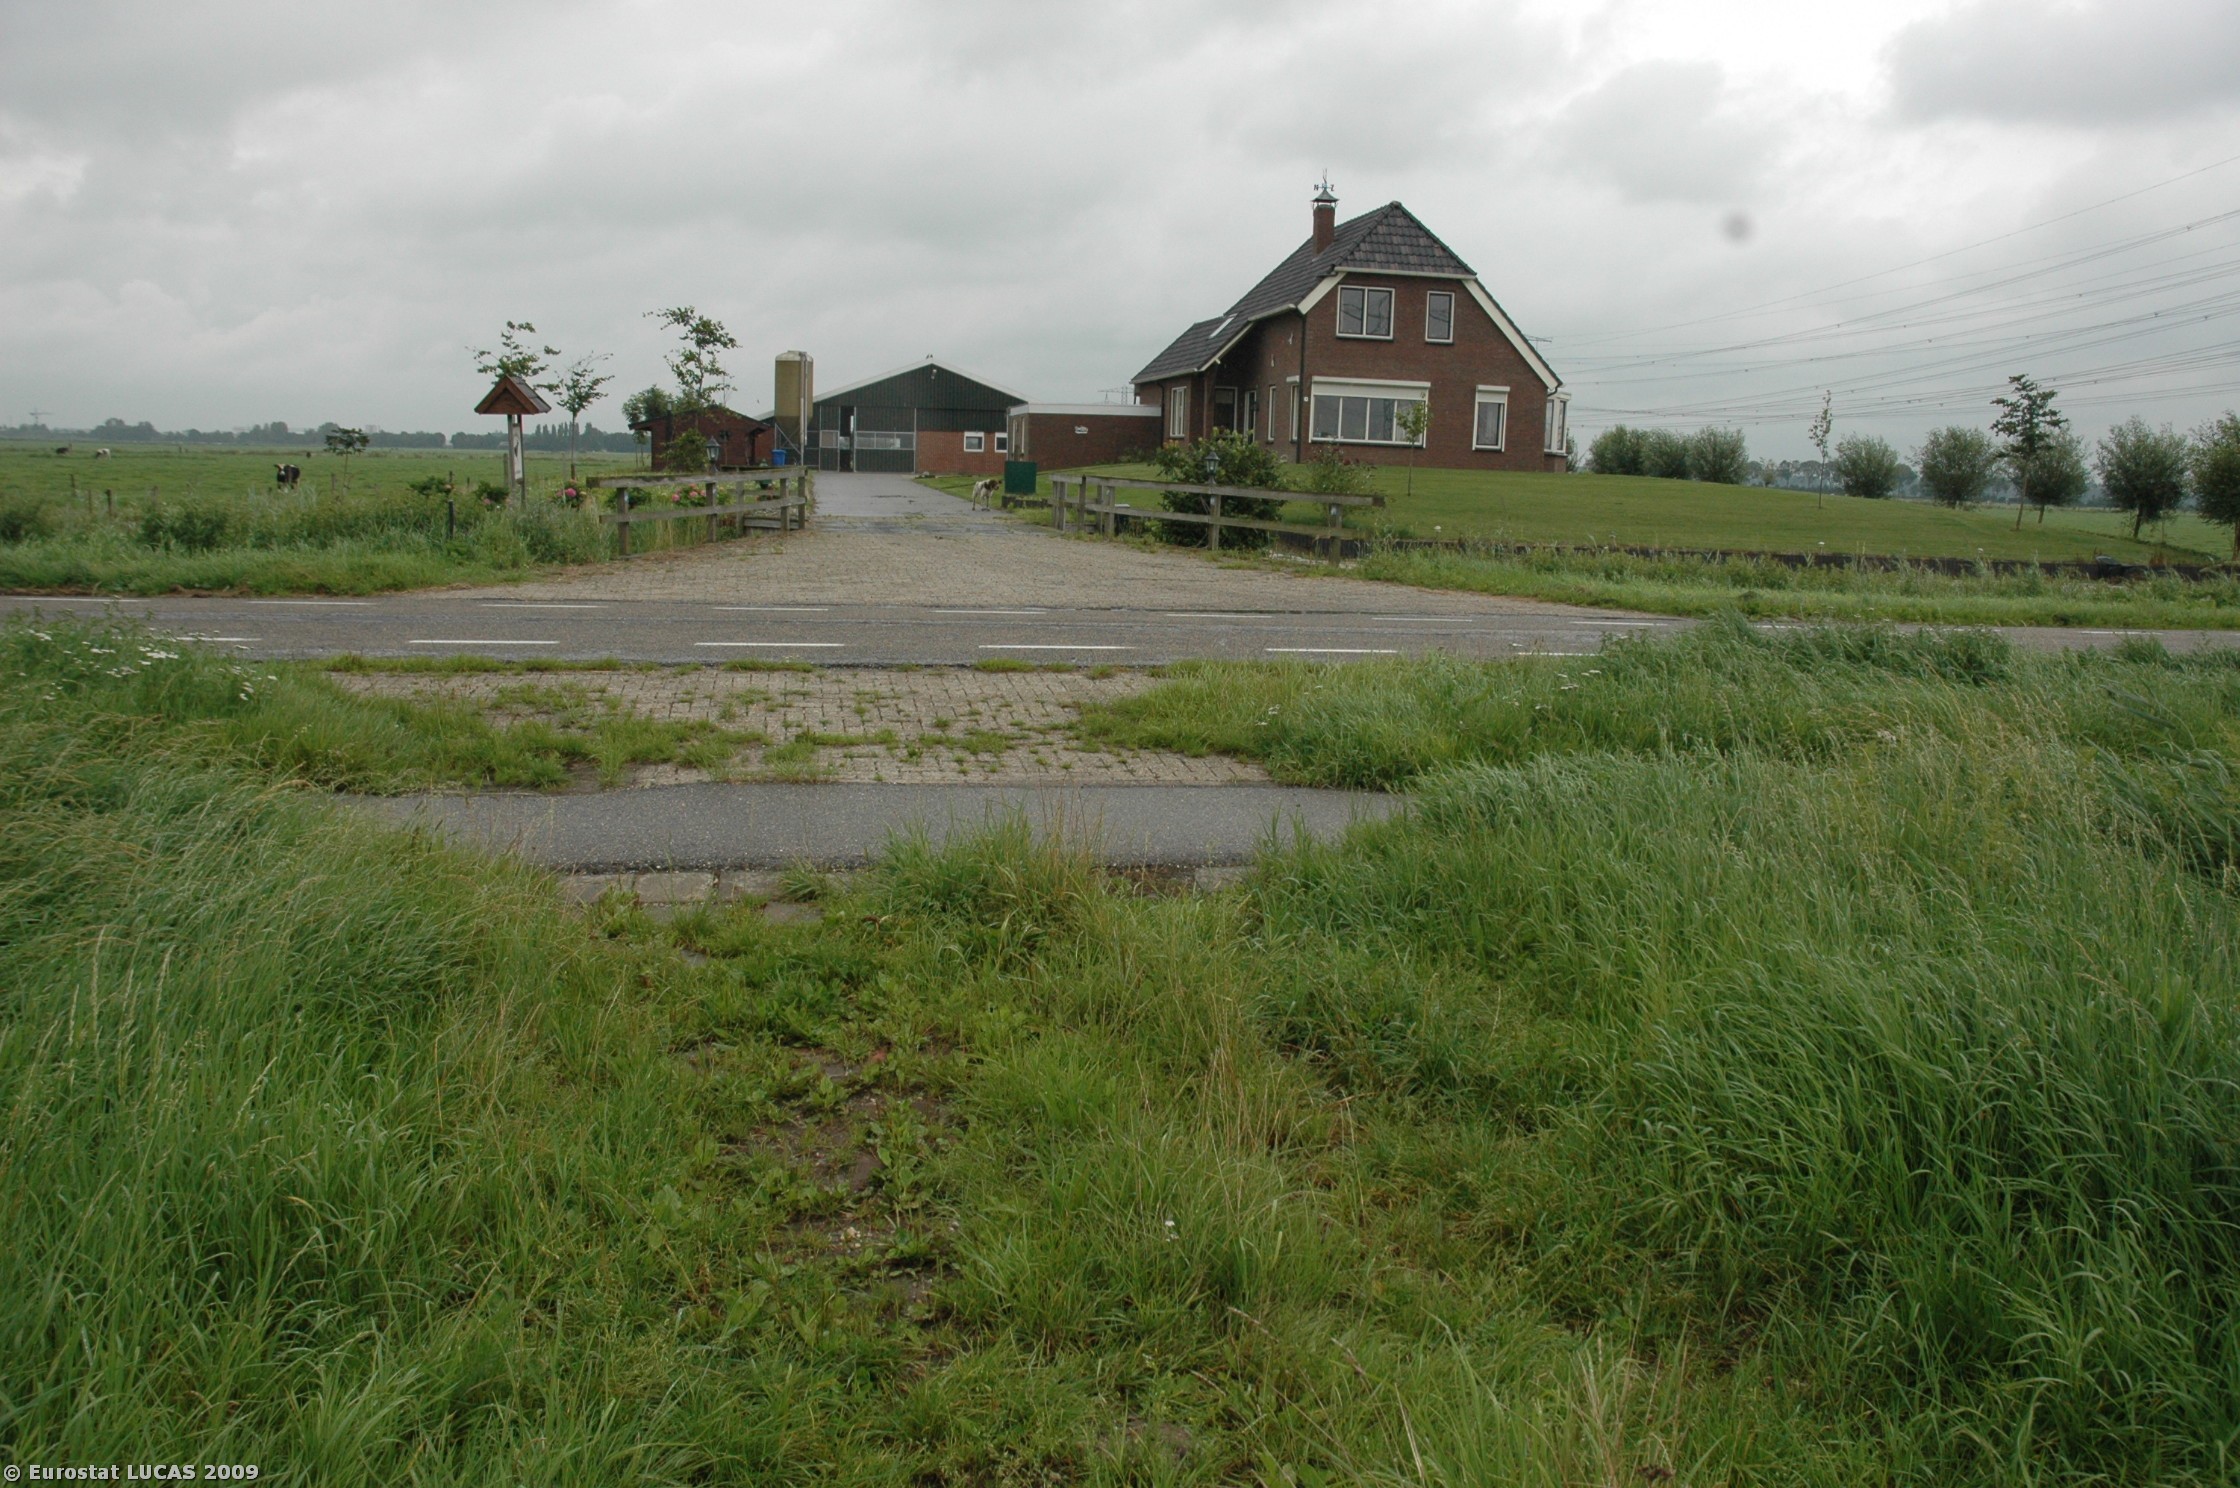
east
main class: Grassland
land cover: Grassland without tree/shrub cover
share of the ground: > 75 %
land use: Agriculture (excluding fallow land and kitchen gardens)
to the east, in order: Grassland without tree/shrub cover; Fences; Ditches and canals; Fences; Grassland without tree/shrub cover; Electric lines
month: August
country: NL
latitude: 52.5641
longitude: 6.0605
